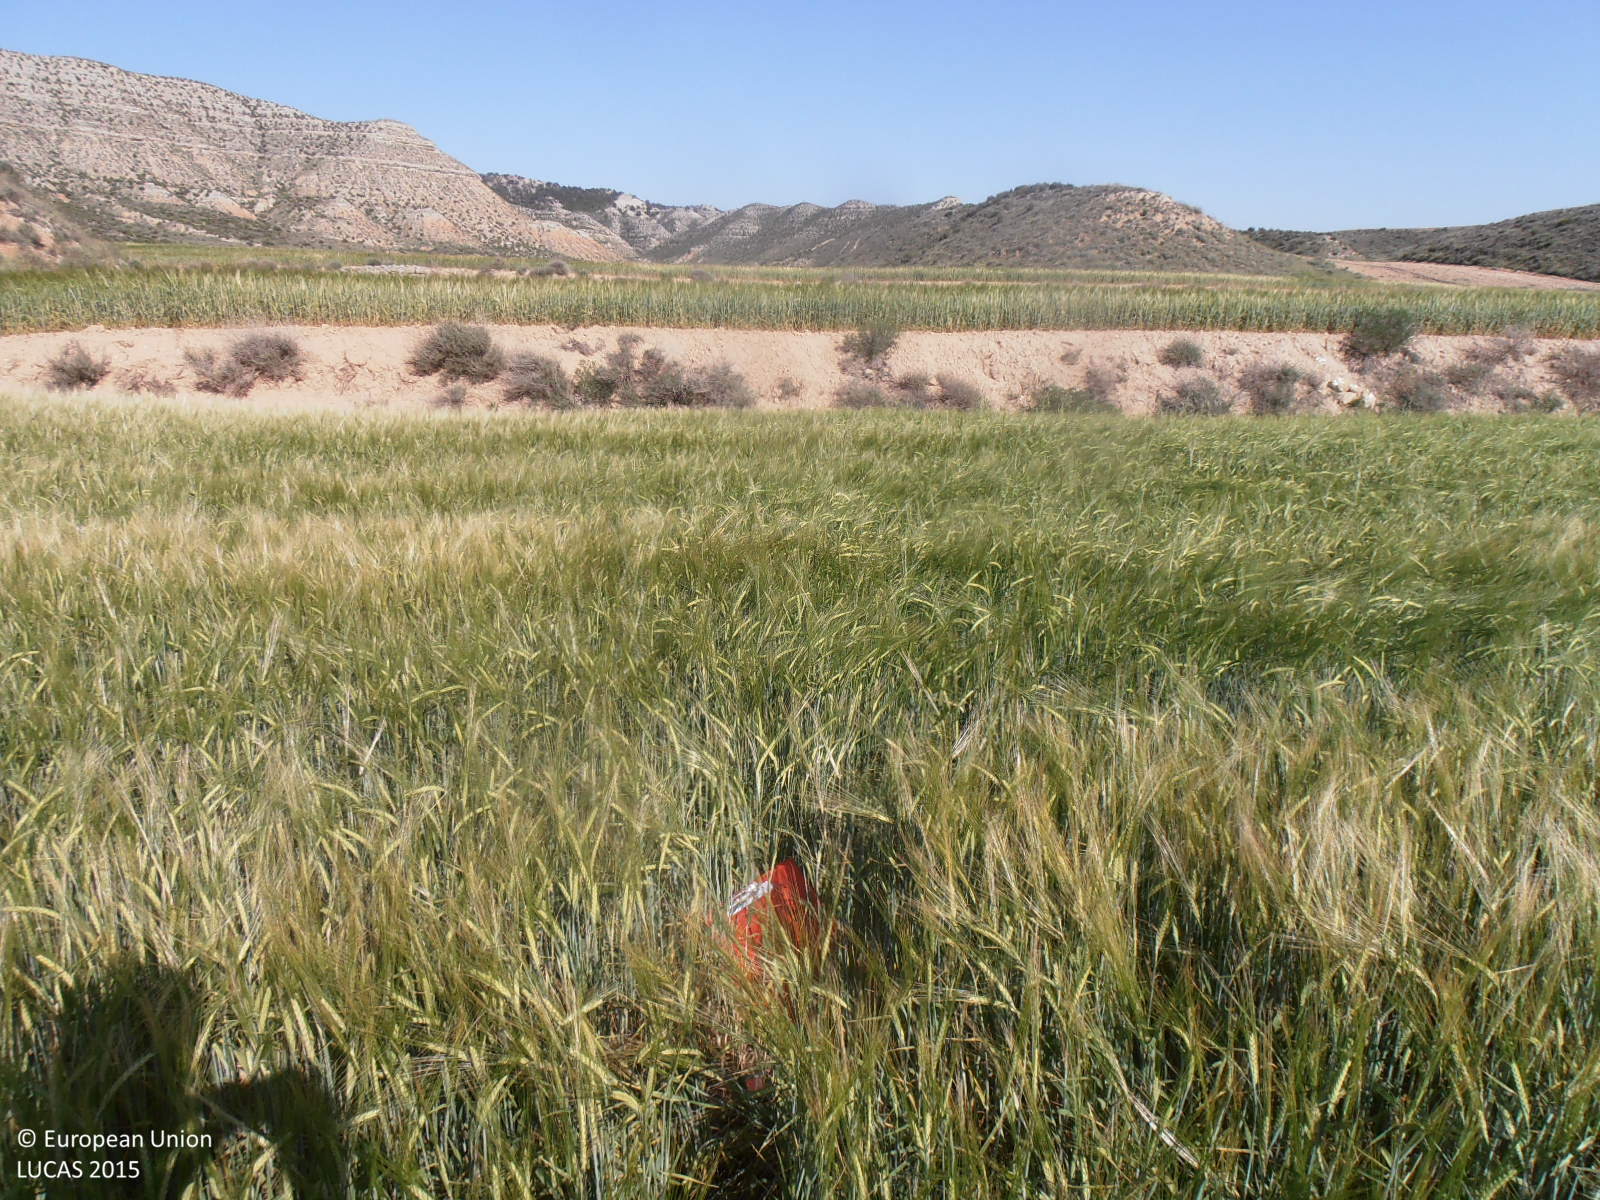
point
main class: Cropland
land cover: Barley
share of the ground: > 75 %
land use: Agriculture (excluding fallow land and kitchen gardens)
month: May
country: ES
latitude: 41.4879
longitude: -1.0043
